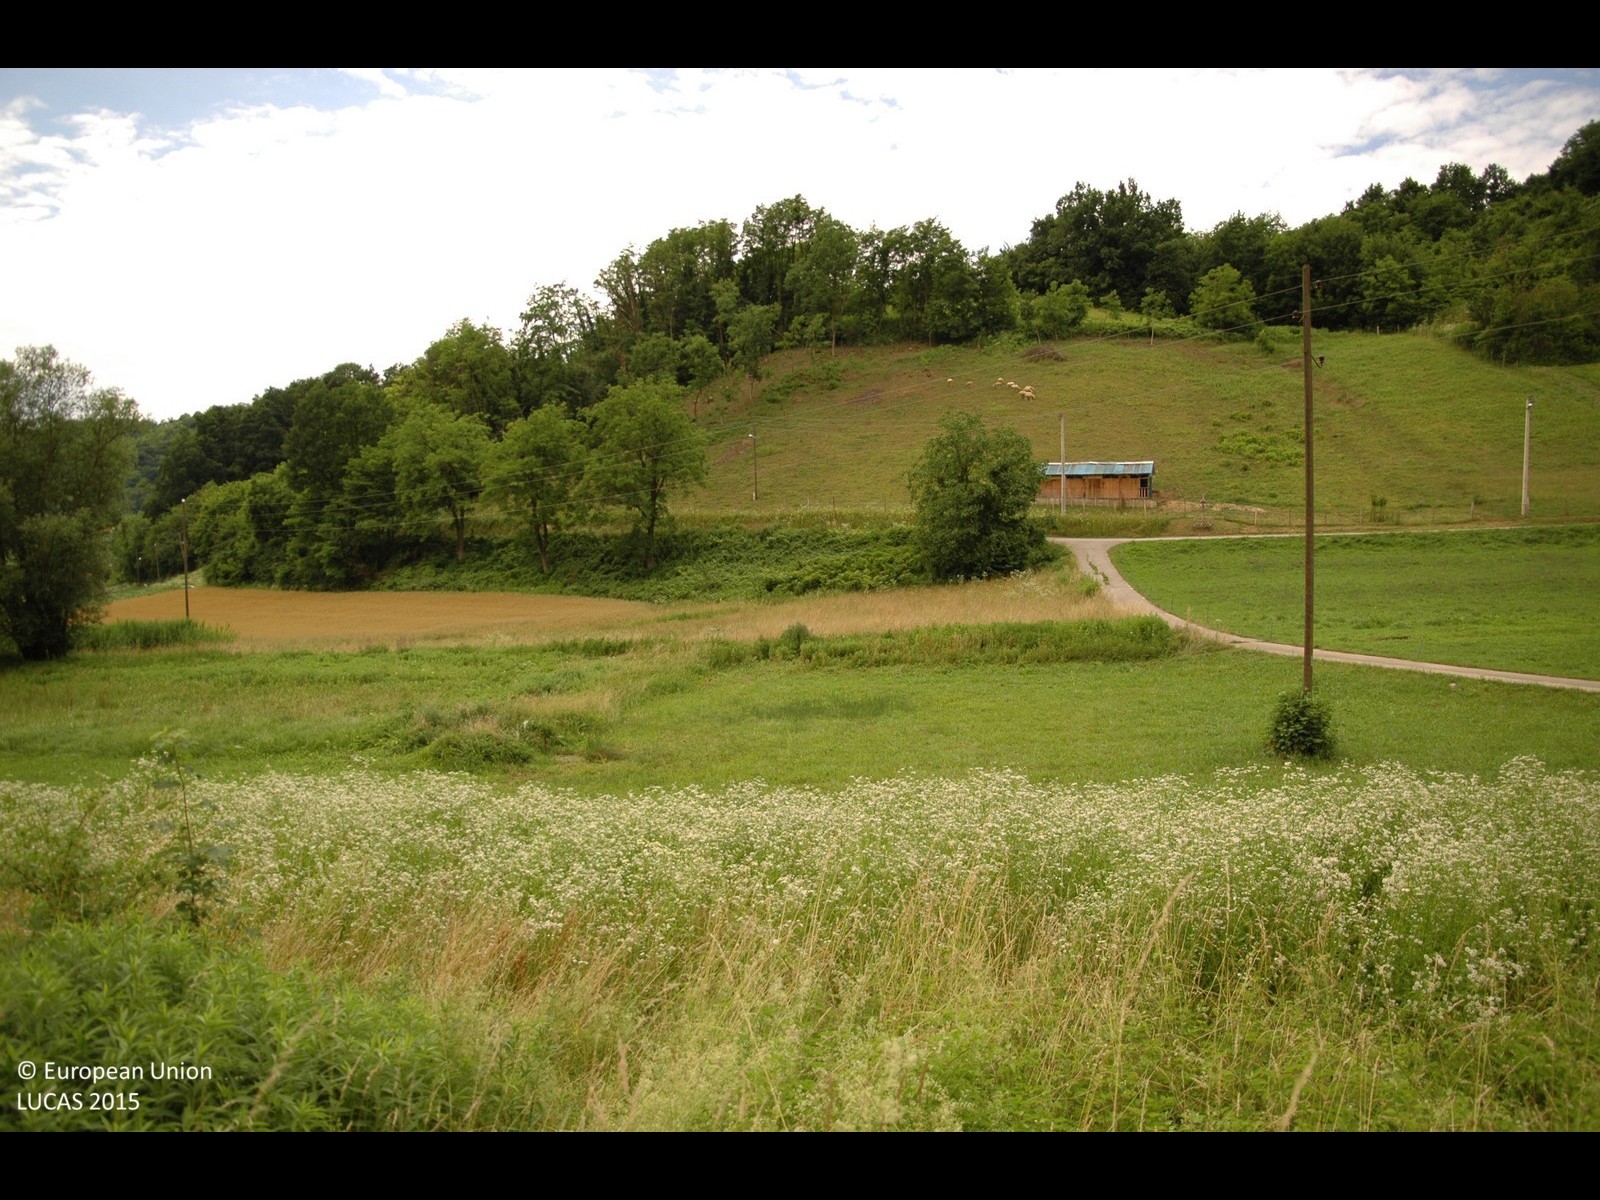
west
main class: Grassland
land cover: Spontaneously vegetated surfaces
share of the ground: > 75 %
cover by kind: herbaceous plants 95 %, shrubs 5 %
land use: Abandoned areas
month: June
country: HR
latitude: 46.0989
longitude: 15.8841
